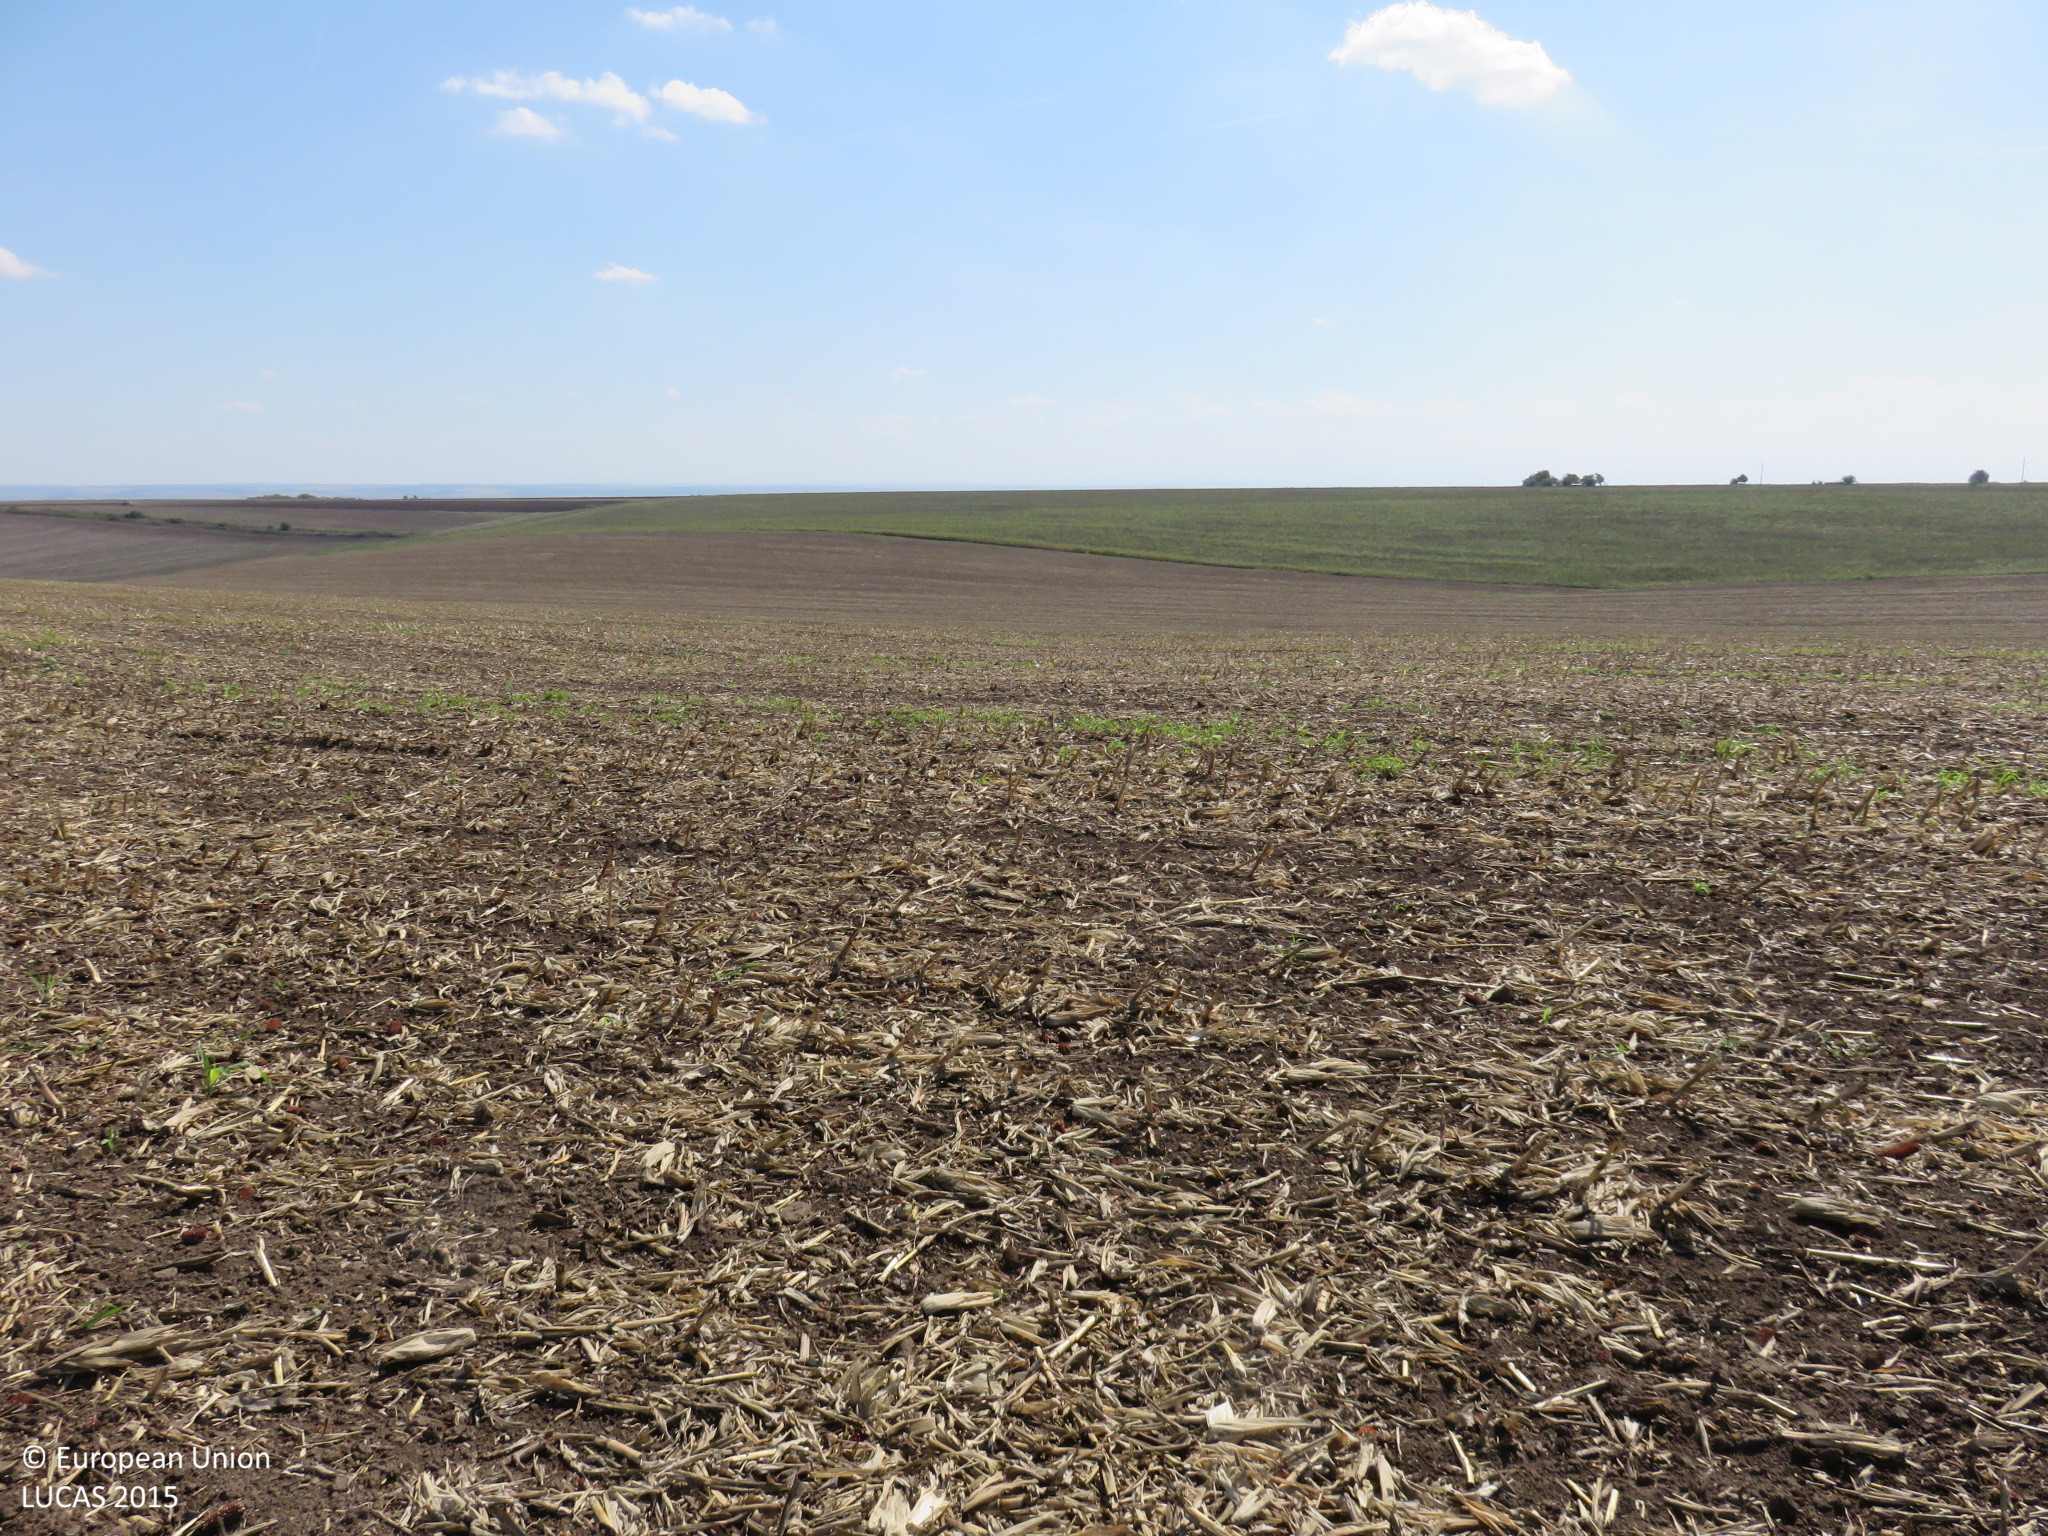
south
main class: Cropland
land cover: Maize
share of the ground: > 75 %
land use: Agriculture (excluding fallow land and kitchen gardens)
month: September
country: BG
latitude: 43.6187
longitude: 24.4992
